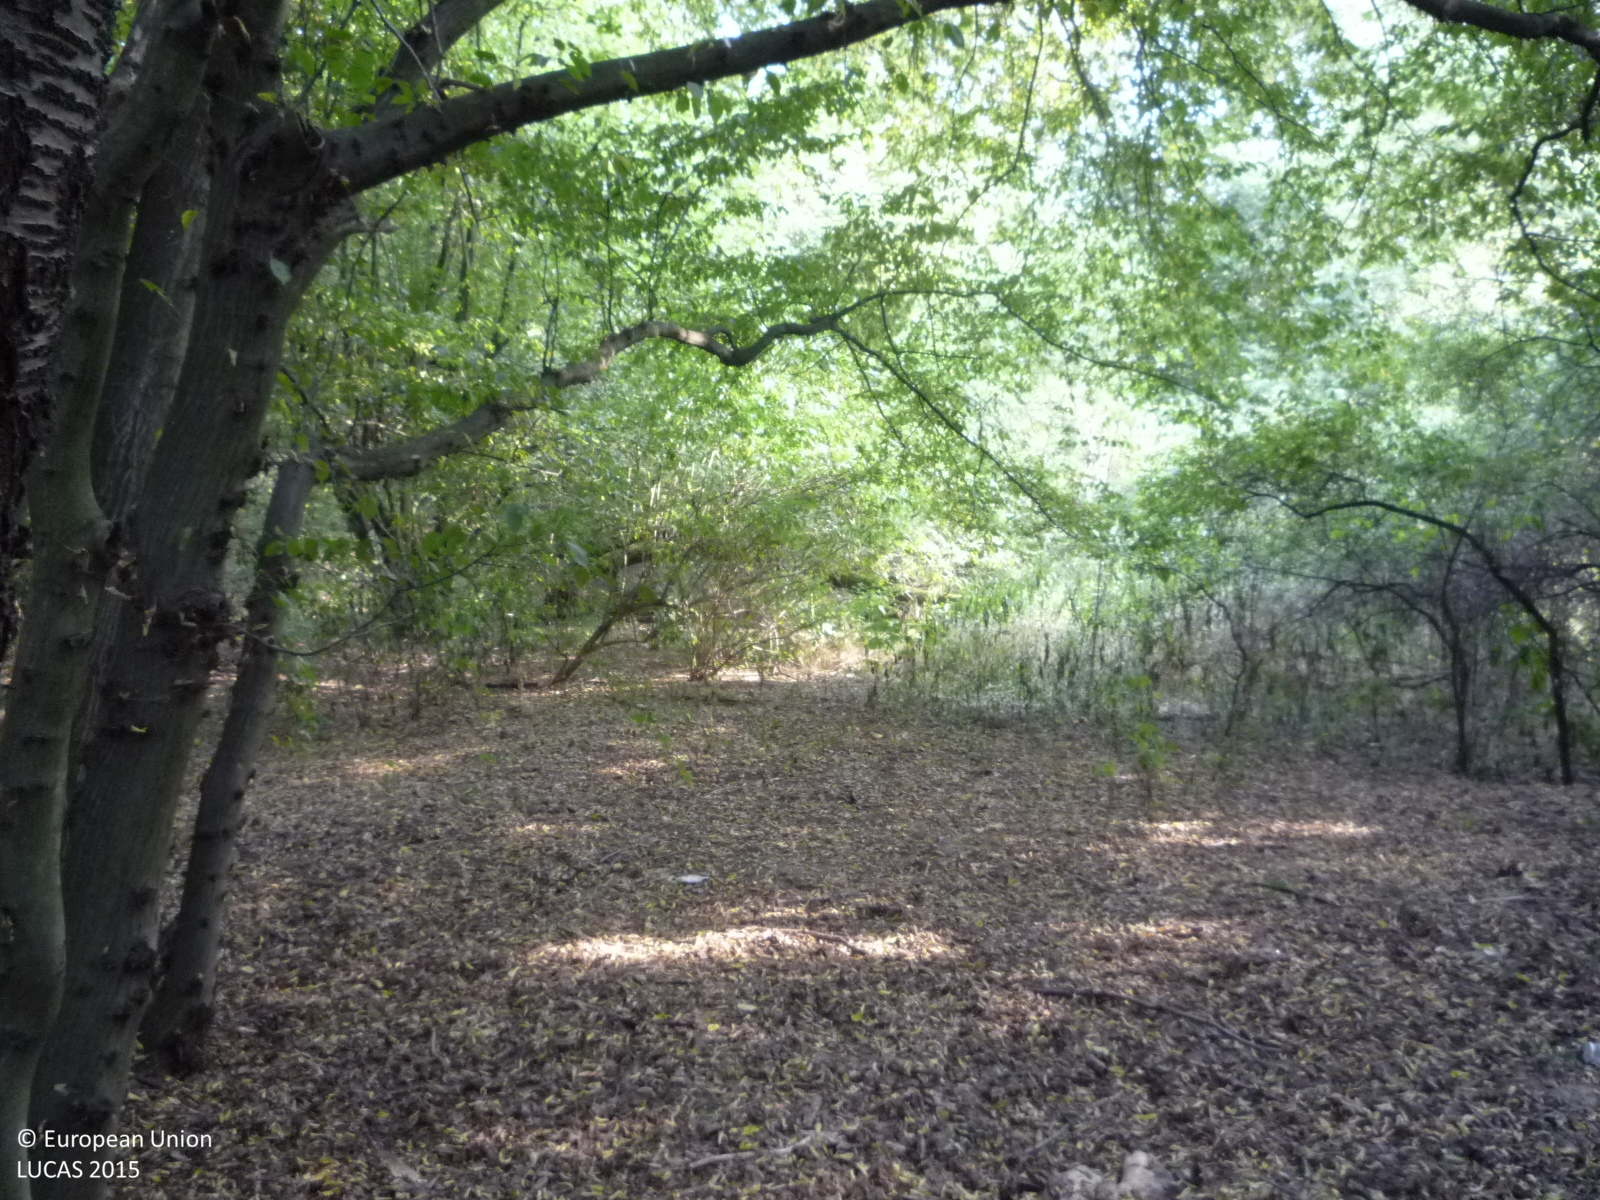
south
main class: Woodland
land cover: Broadleaved woodland
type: mesophytic deciduous forest
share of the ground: > 75 %
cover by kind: broadleaved forest trees 95 %, unconsolidated bare surface 5 %
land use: Forestry
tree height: > 5 m
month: August
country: CZ
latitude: 49.8267
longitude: 14.4638
